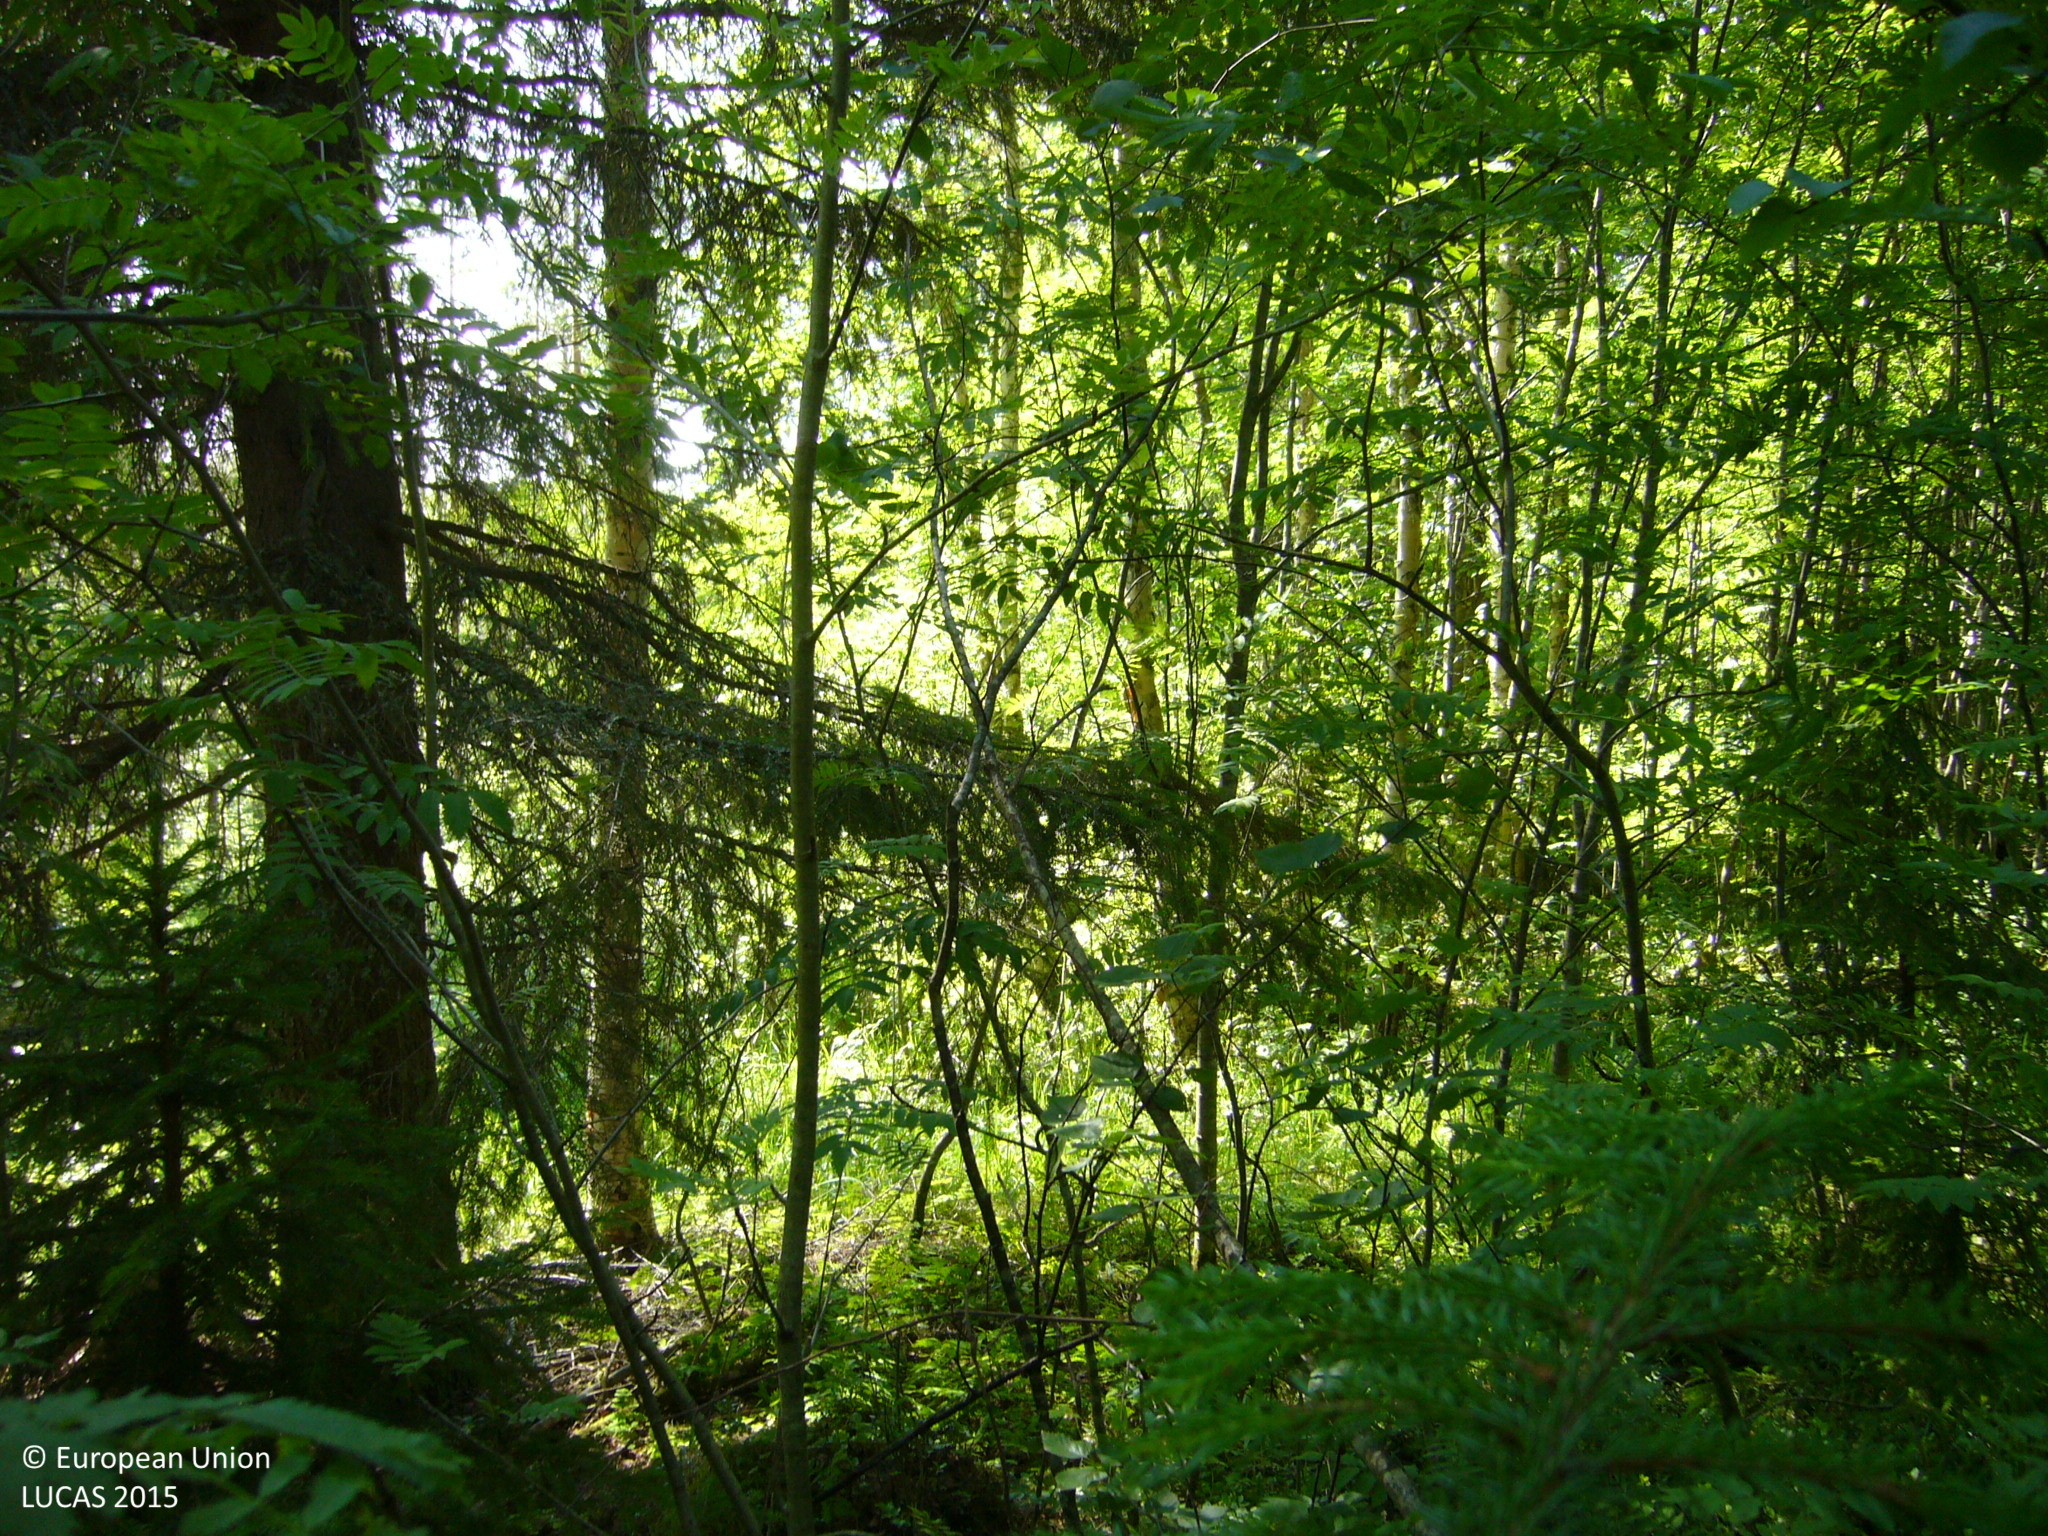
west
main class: Woodland
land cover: Spruce dominated mixed woodland
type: boreal forest
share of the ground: > 75 %
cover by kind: coniferous forest trees 50 %, broadleaved forest trees 40 %, shrubs 10 %
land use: Forestry
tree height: > 5 m
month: July
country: FI
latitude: 63.4081
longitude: 26.0342
